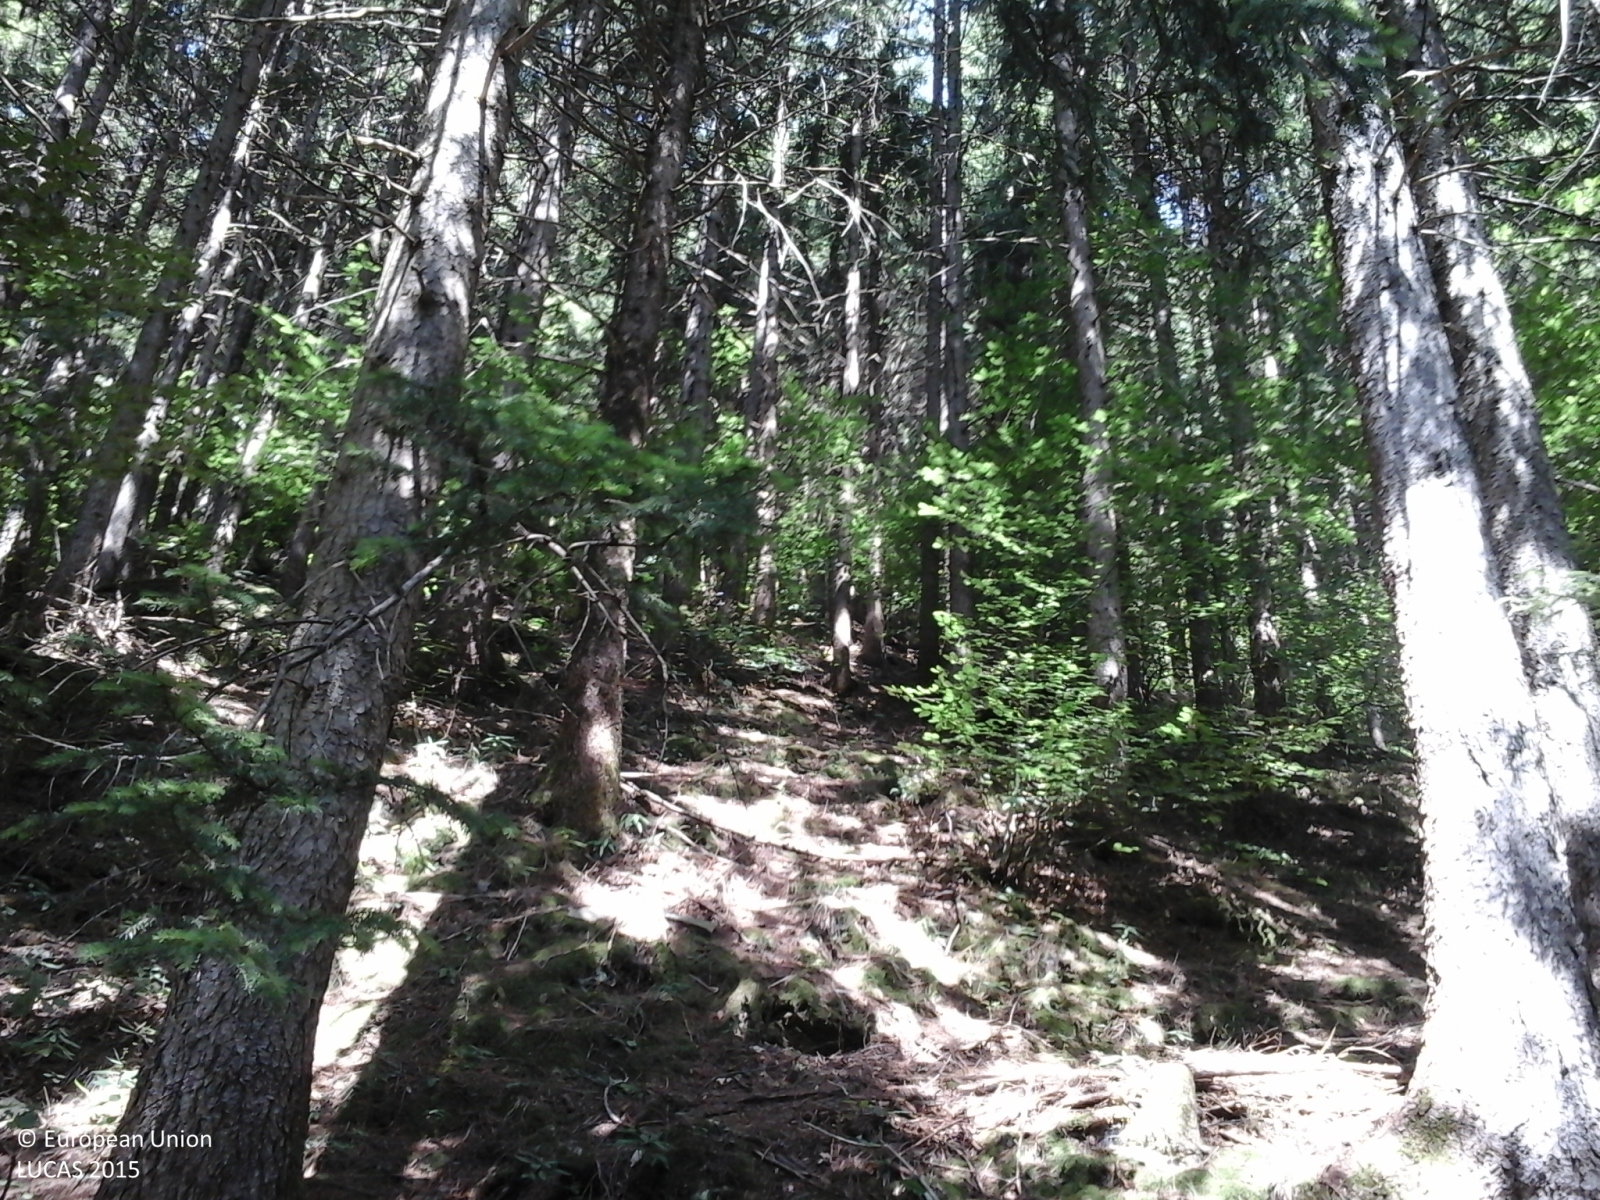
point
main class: Woodland
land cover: Spruce dominated coniferous woodland
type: alpine coniferous forest
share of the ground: > 75 %
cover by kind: coniferous forest trees 75 %, broadleaved forest trees 25 %
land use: Semi-natural and natural areas not in use
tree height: > 5 m
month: July
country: IT
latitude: 46.0089
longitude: 10.1161
